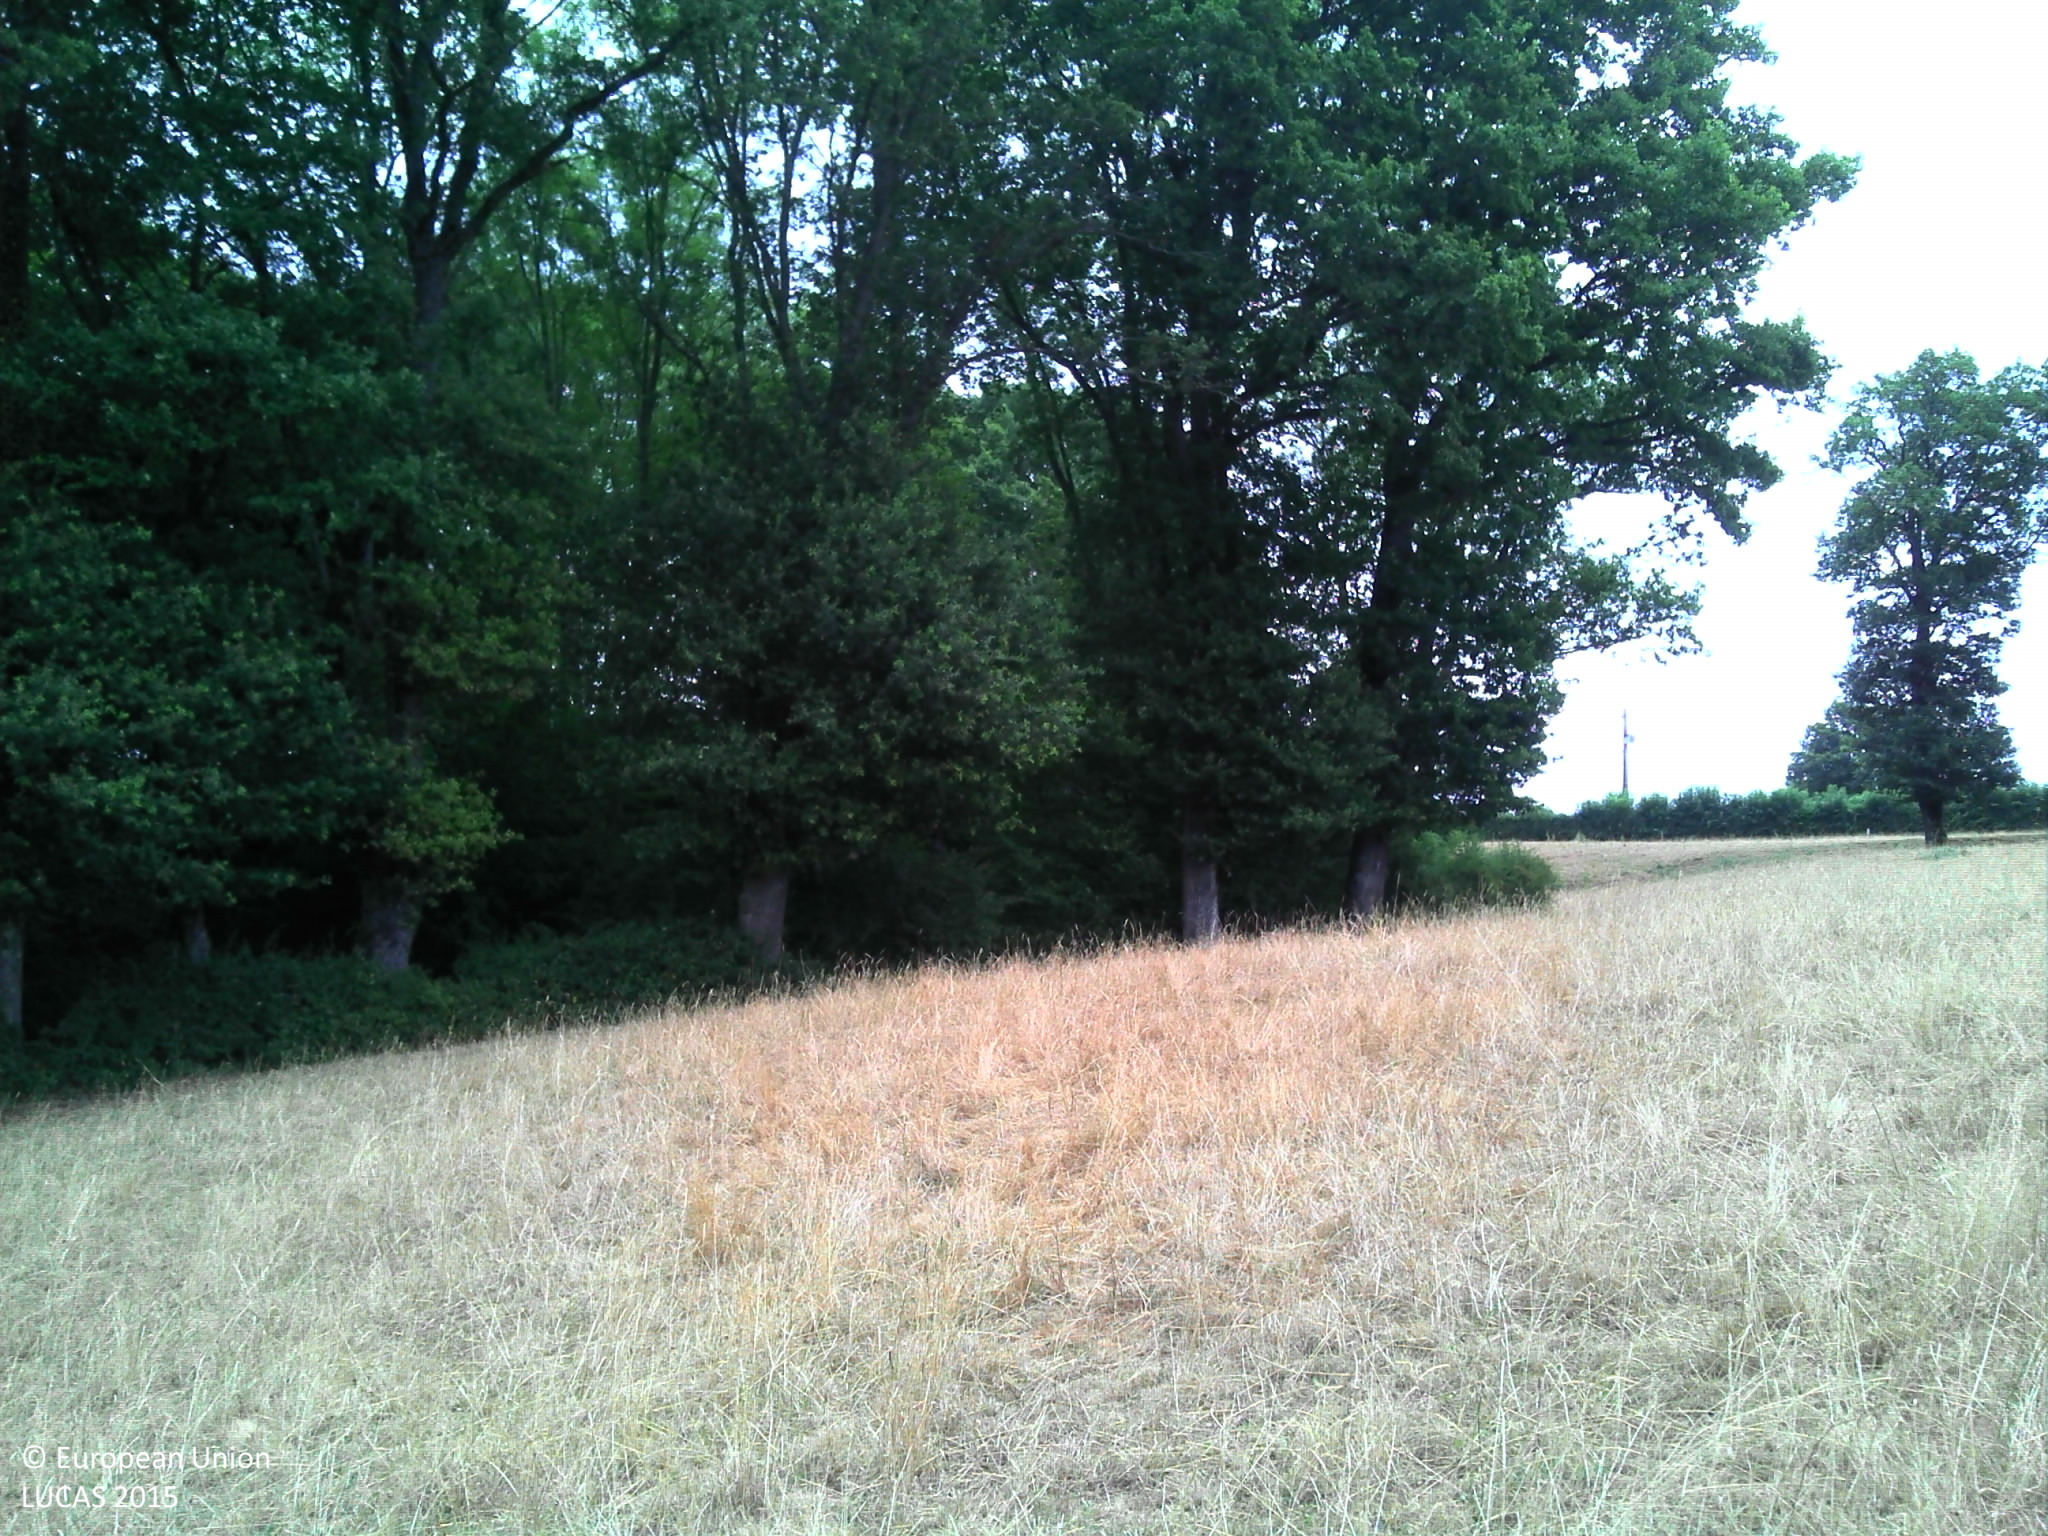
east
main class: Grassland
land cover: Grassland without tree/shrub cover
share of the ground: > 75 %
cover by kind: herbaceous plants 100 %
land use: Agriculture (excluding fallow land and kitchen gardens)
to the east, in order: Grassland without tree/shrub cover; Broadleaved woodland; Ditches and canals; Broadleaved woodland; Fences; Grassland without tree/shrub cover; Broadleaved woodland; Grassland without tree/shrub cover; Fences; Managed hedges; Electric lines; Grass margins; Paved roads, cycling and walking lanes; Grass margins; Managed hedges; Electric lines; Fences; Common wheat
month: July
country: FR
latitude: 46.6268
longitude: 2.9831
